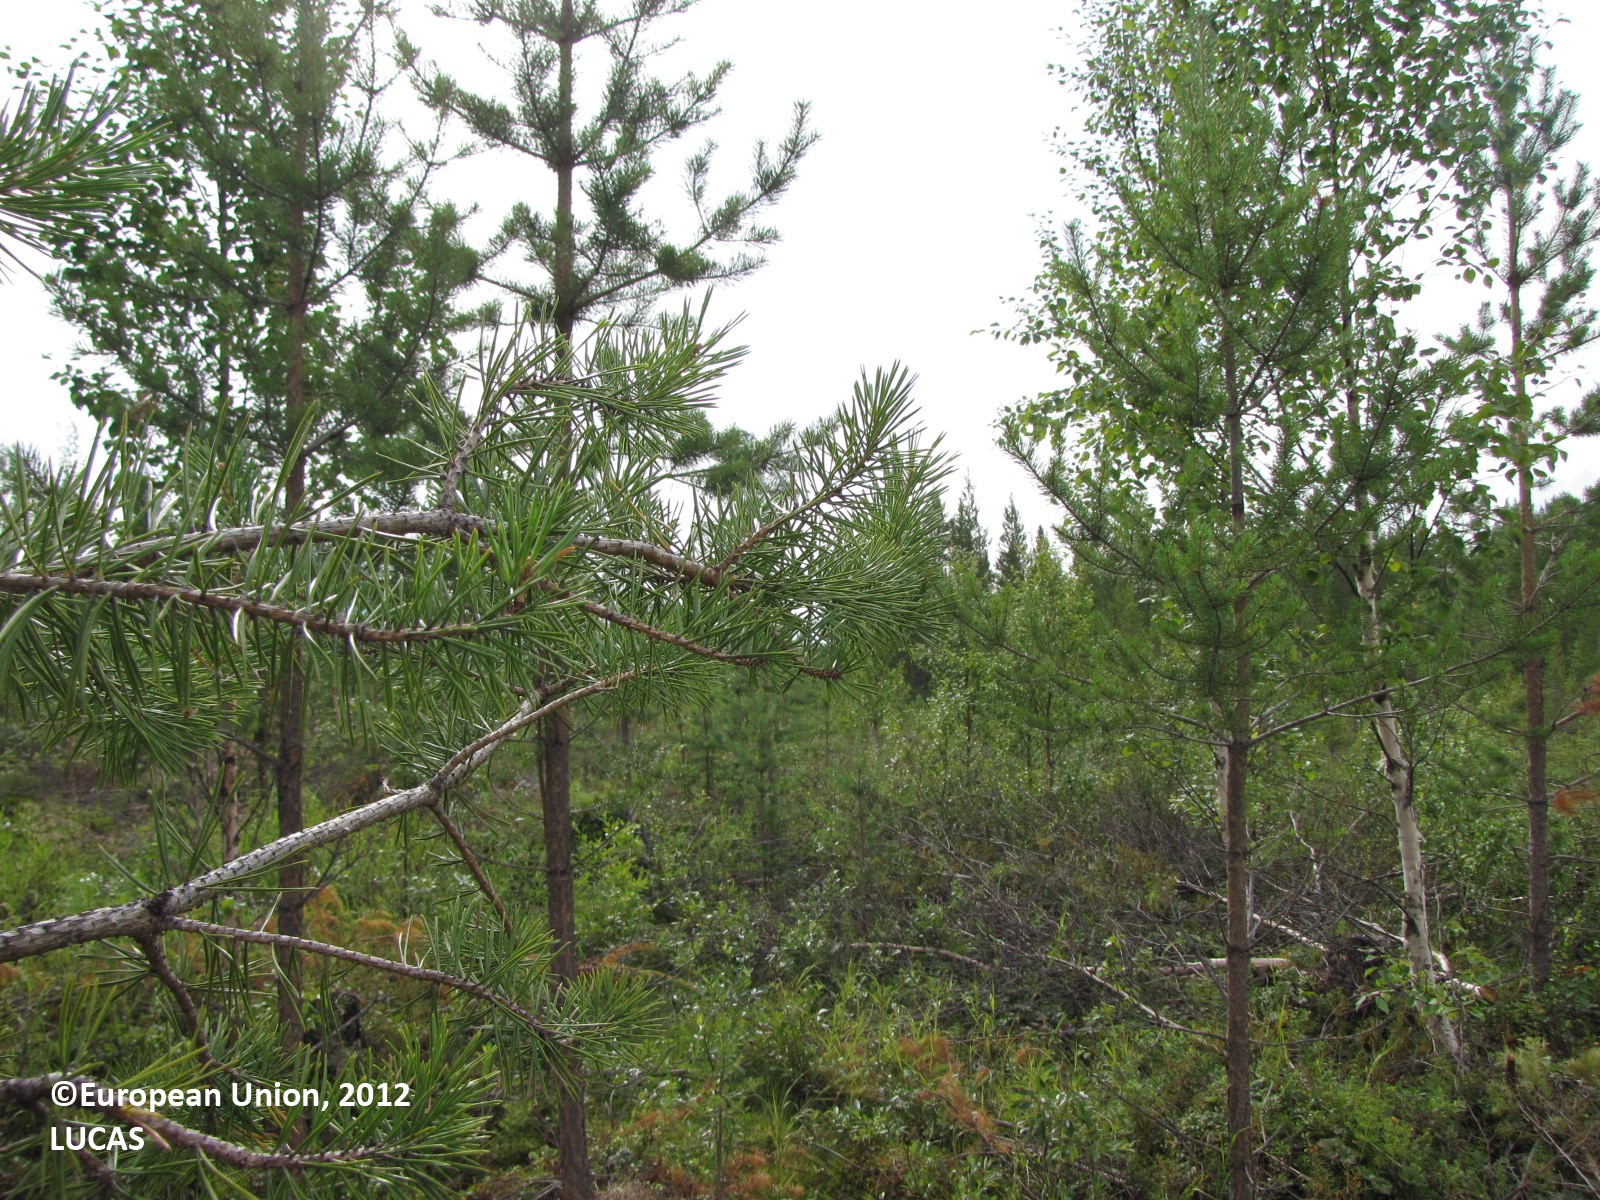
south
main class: Woodland
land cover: Pine dominated mixed woodland
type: boreal forest
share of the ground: 25 - 50 %
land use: Forestry
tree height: > 5 m
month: August
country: FI
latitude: 66.7328
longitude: 24.5385
